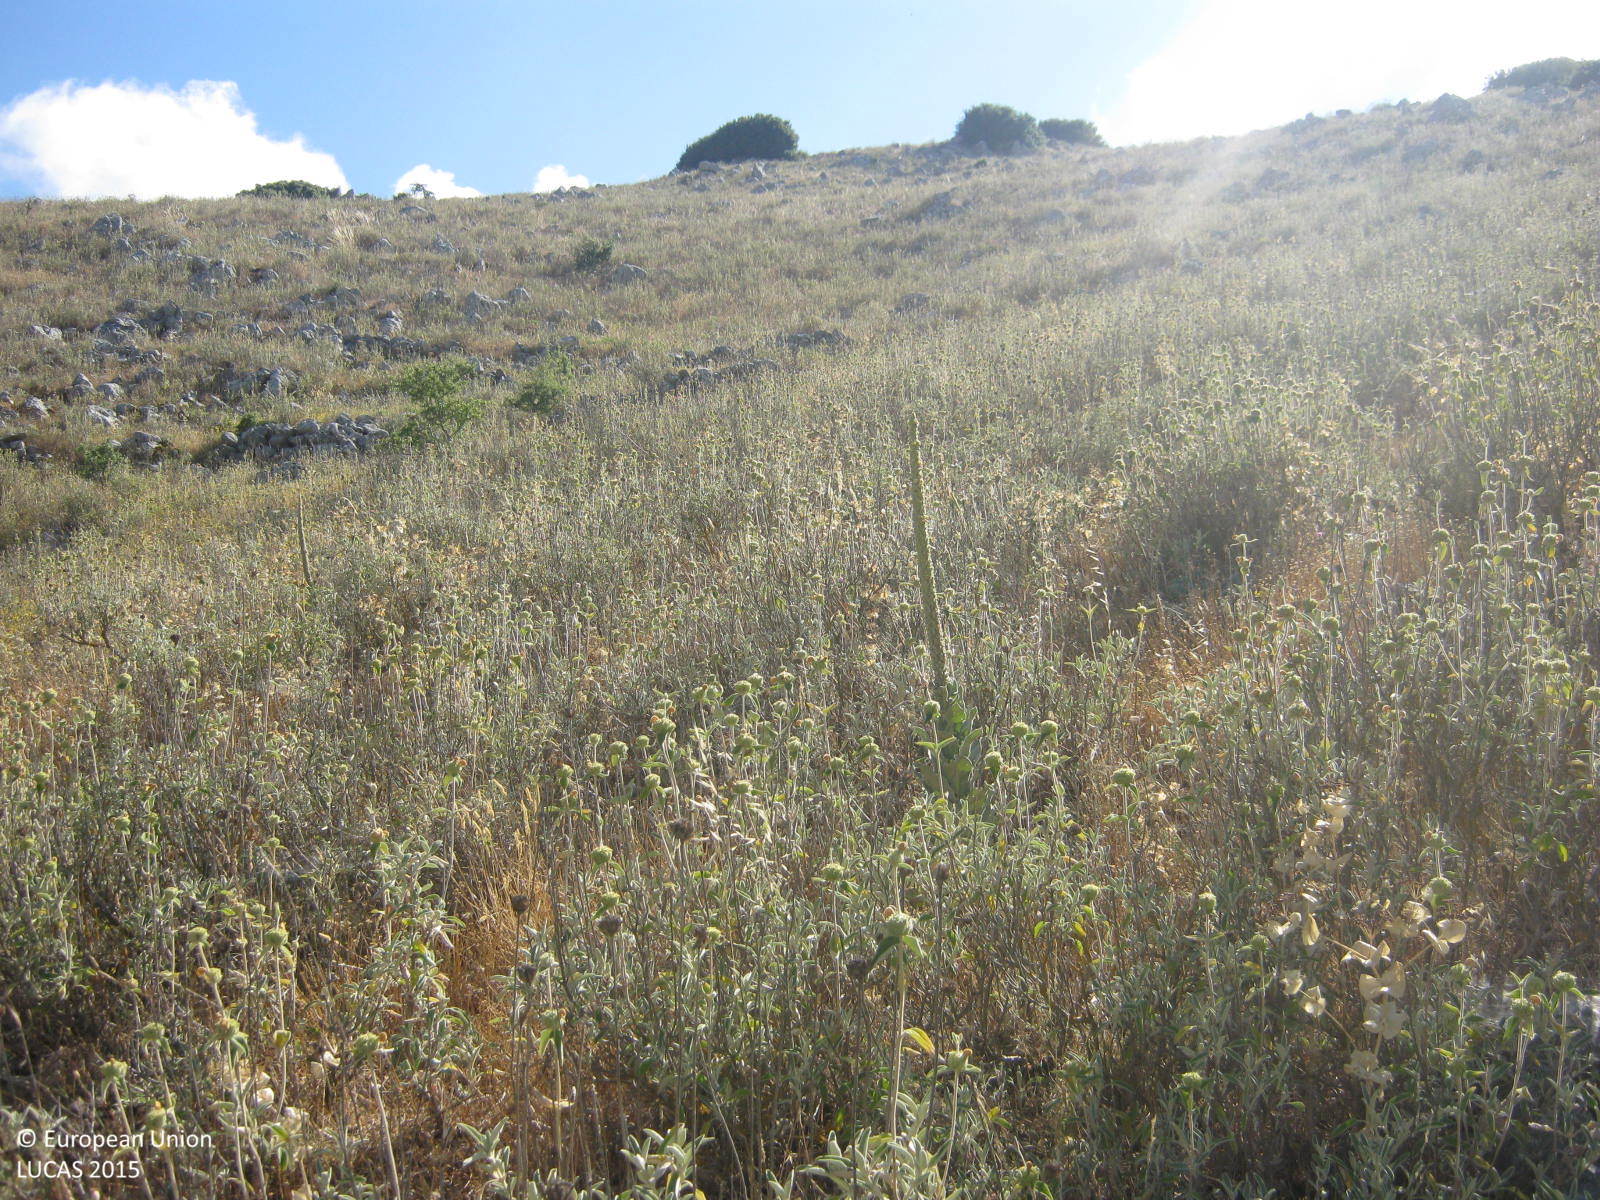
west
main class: Shrubland
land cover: Shrubland without tree cover
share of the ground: 25 - 50 %
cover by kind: shrubs 50 %, herbaceous plants 25 %, consolidated bare surface 25 %
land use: Semi-natural and natural areas not in use
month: June
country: GR
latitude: 38.7212
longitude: 20.6293
